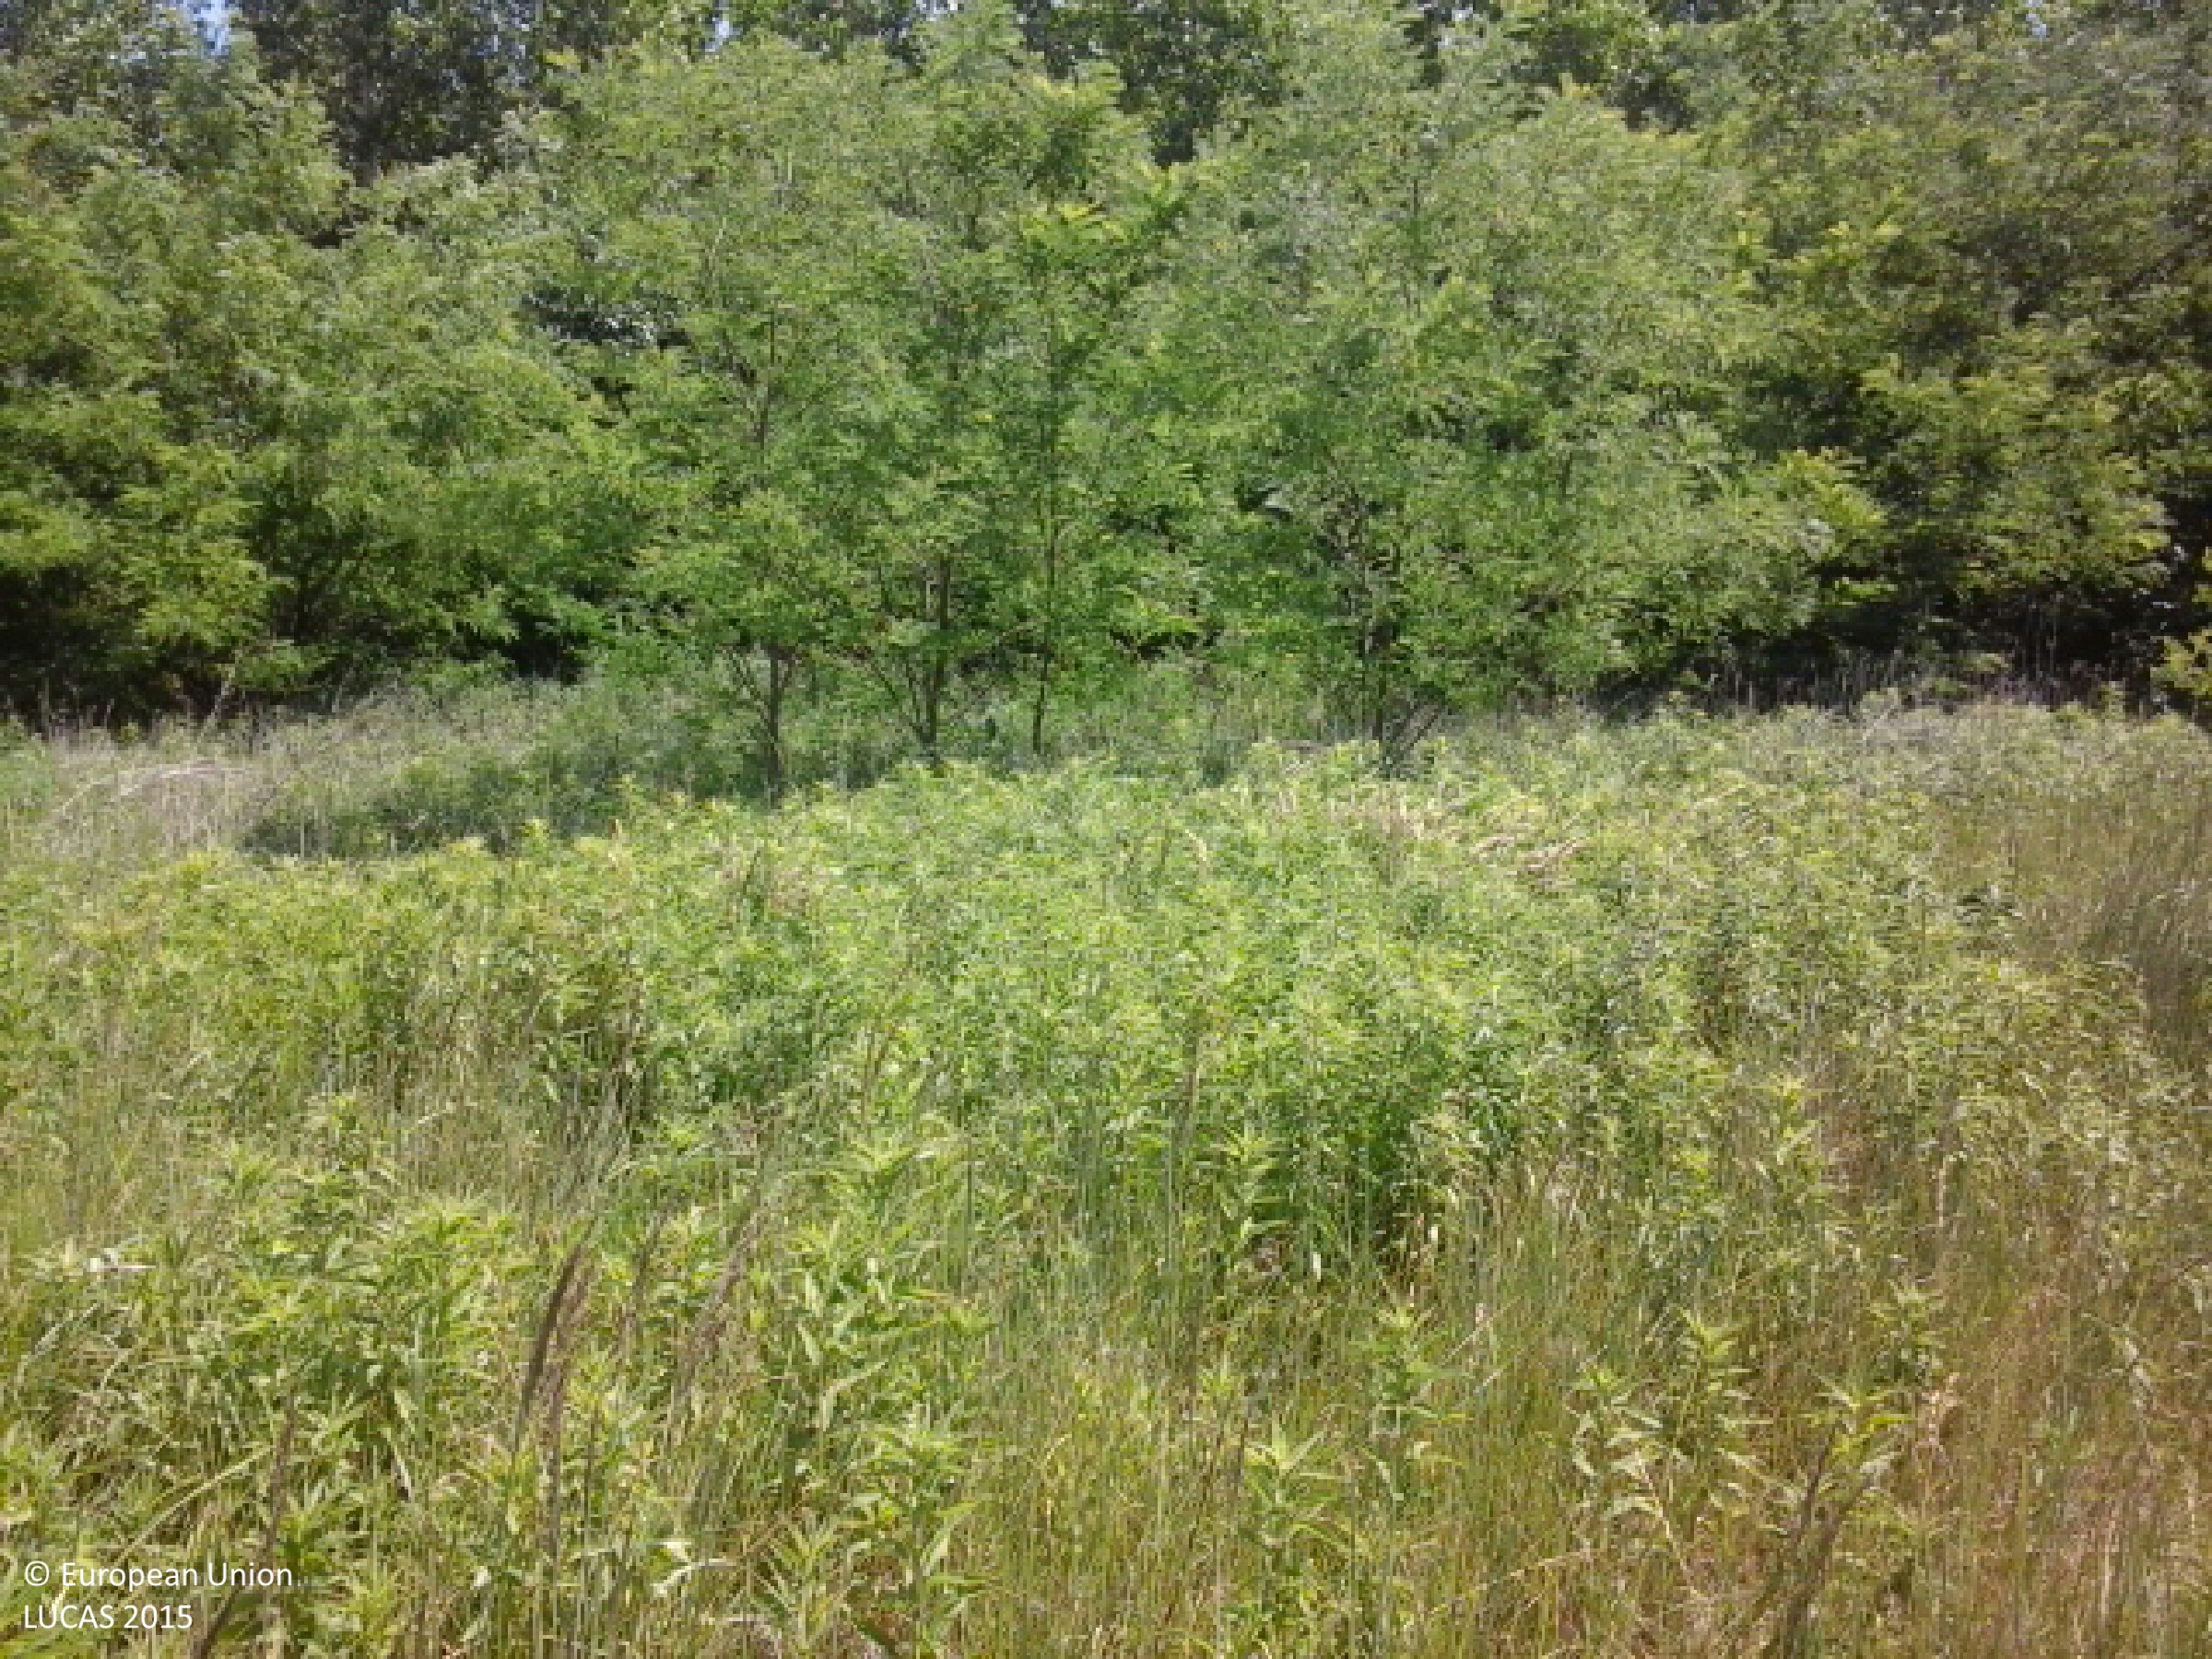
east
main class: Grassland
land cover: Grassland without tree/shrub cover
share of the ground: > 75 %
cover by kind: herbaceous plants 100 %
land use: Semi-natural and natural areas not in use
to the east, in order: Grassland without tree/shrub cover; Broadleaved woodland; Tracks; Pine dominated coniferous woodland
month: June
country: HU
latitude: 48.0342
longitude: 21.7025
